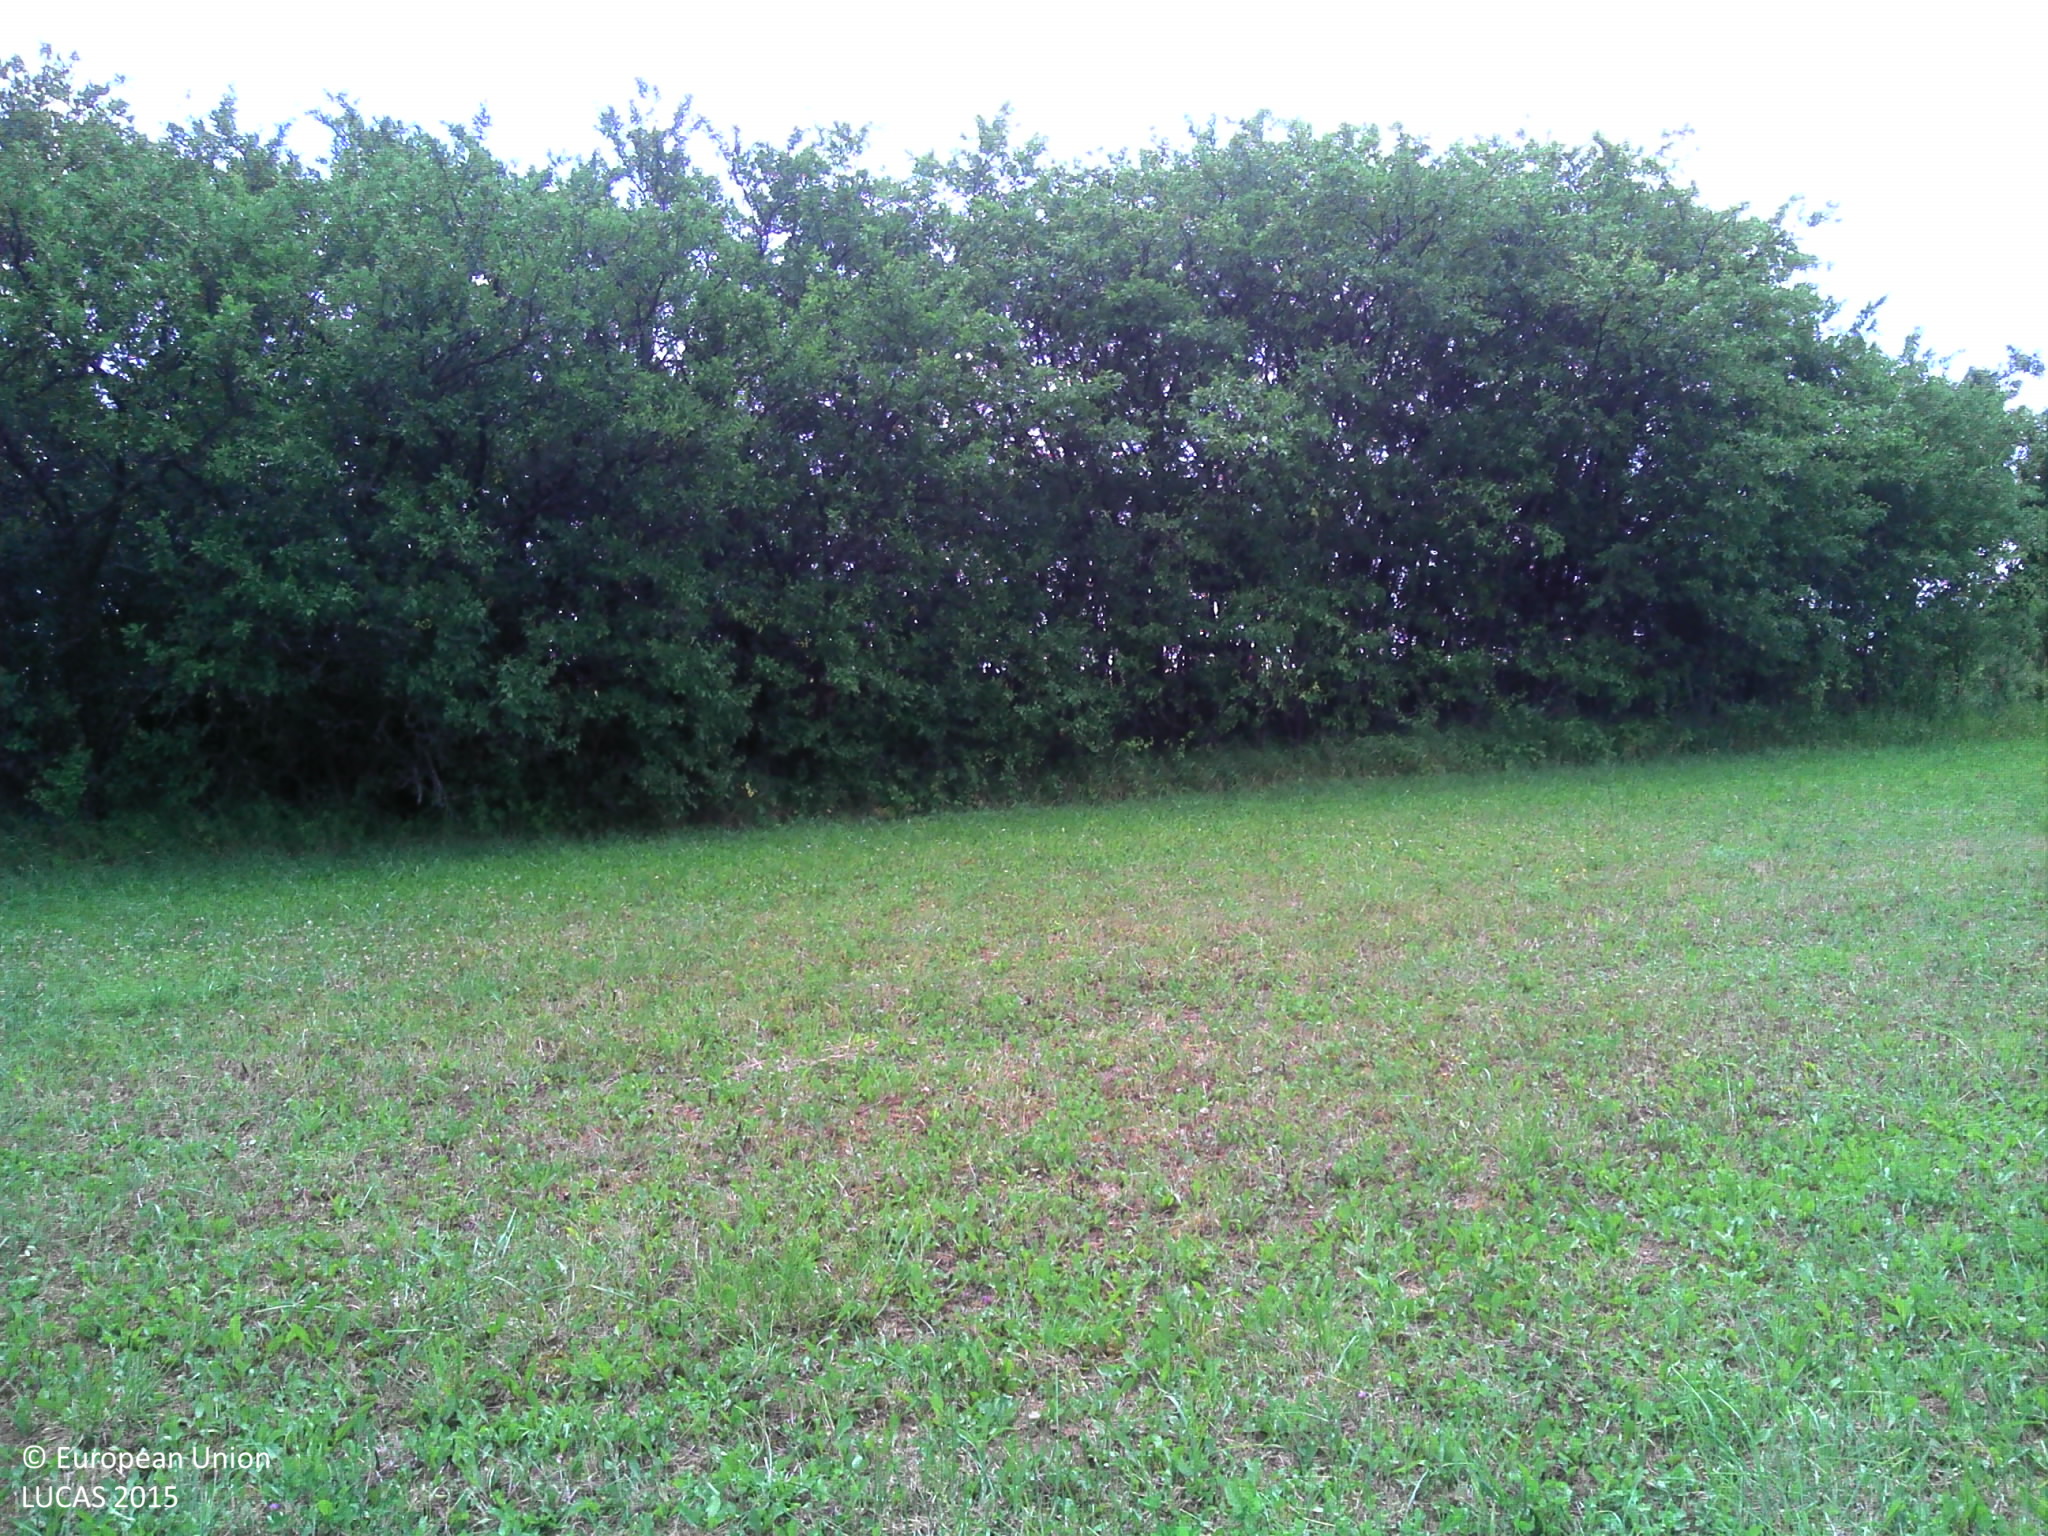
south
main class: Grassland
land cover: Grassland without tree/shrub cover
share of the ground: > 75 %
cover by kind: herbaceous plants 95 %, lichens and mosses 5 %
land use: Agriculture (excluding fallow land and kitchen gardens)
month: June
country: FR
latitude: 48.4275
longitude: 6.1757
